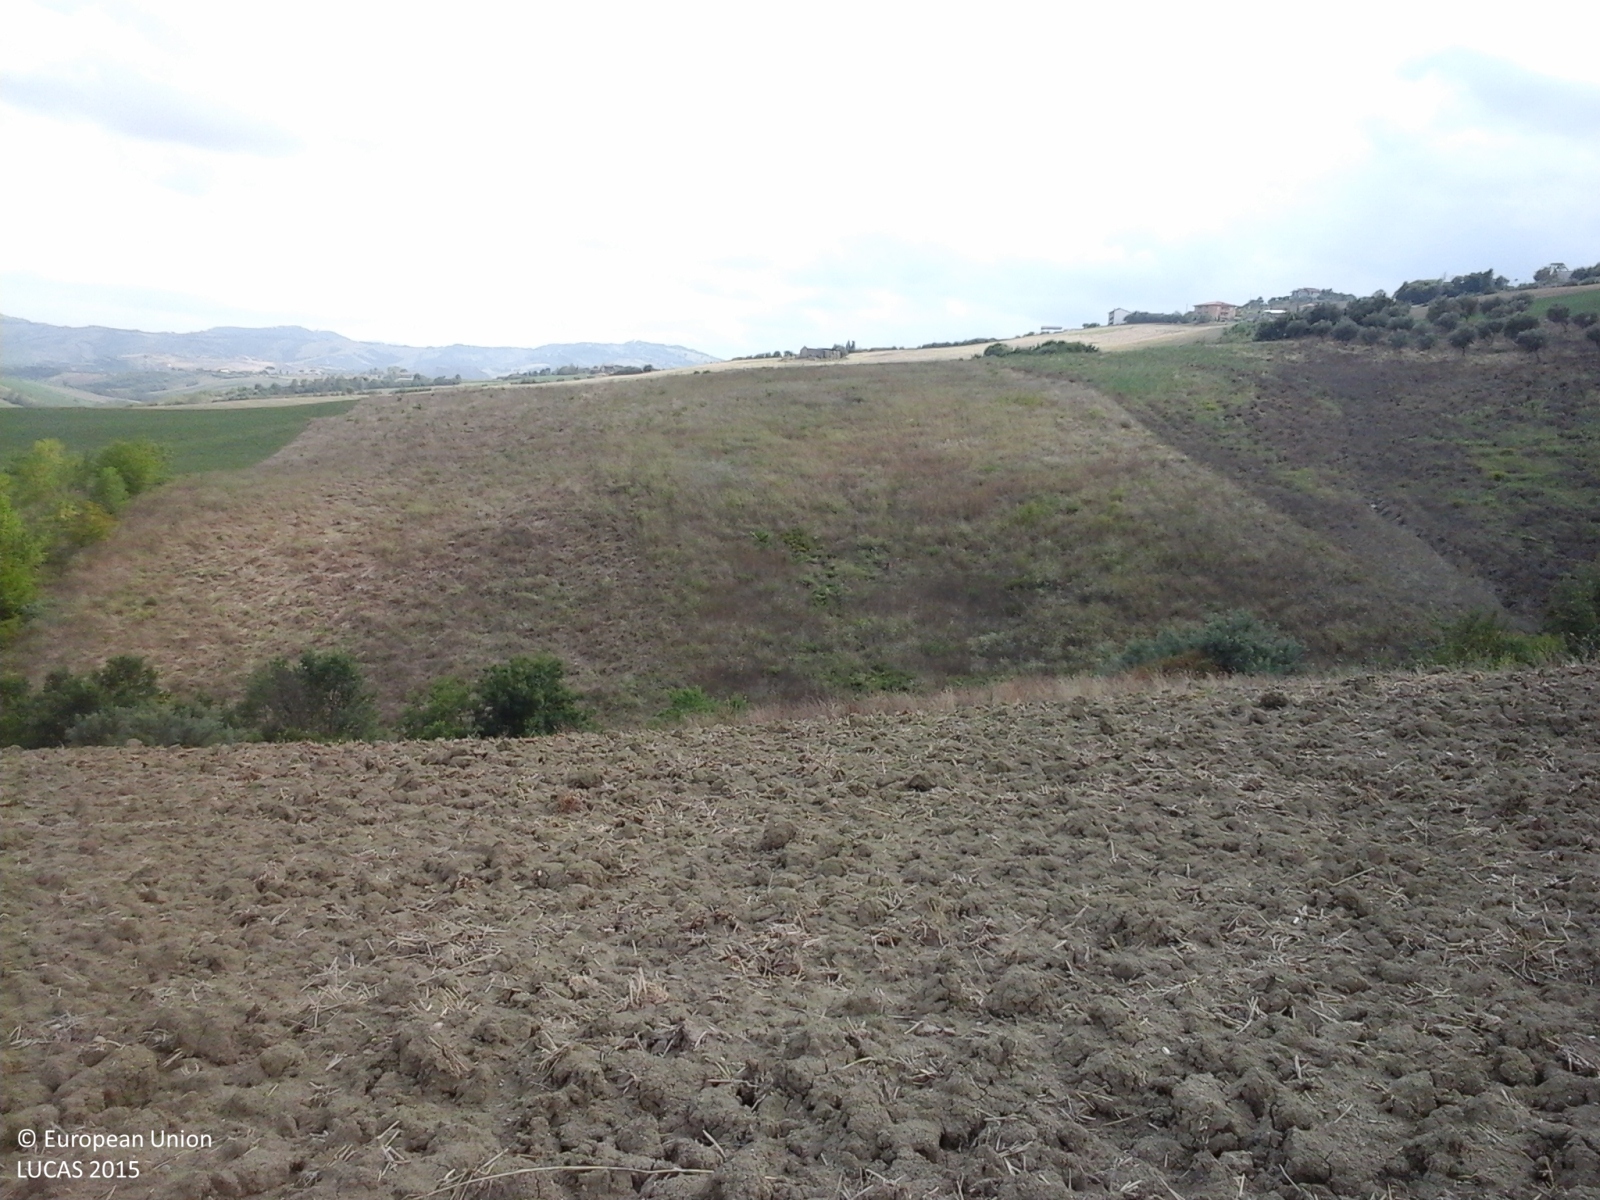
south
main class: Cropland
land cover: Durum wheat
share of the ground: < 10 %
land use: Agriculture (excluding fallow land and kitchen gardens)
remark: Harvested field
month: August
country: IT
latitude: 42.7287
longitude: 13.7630
